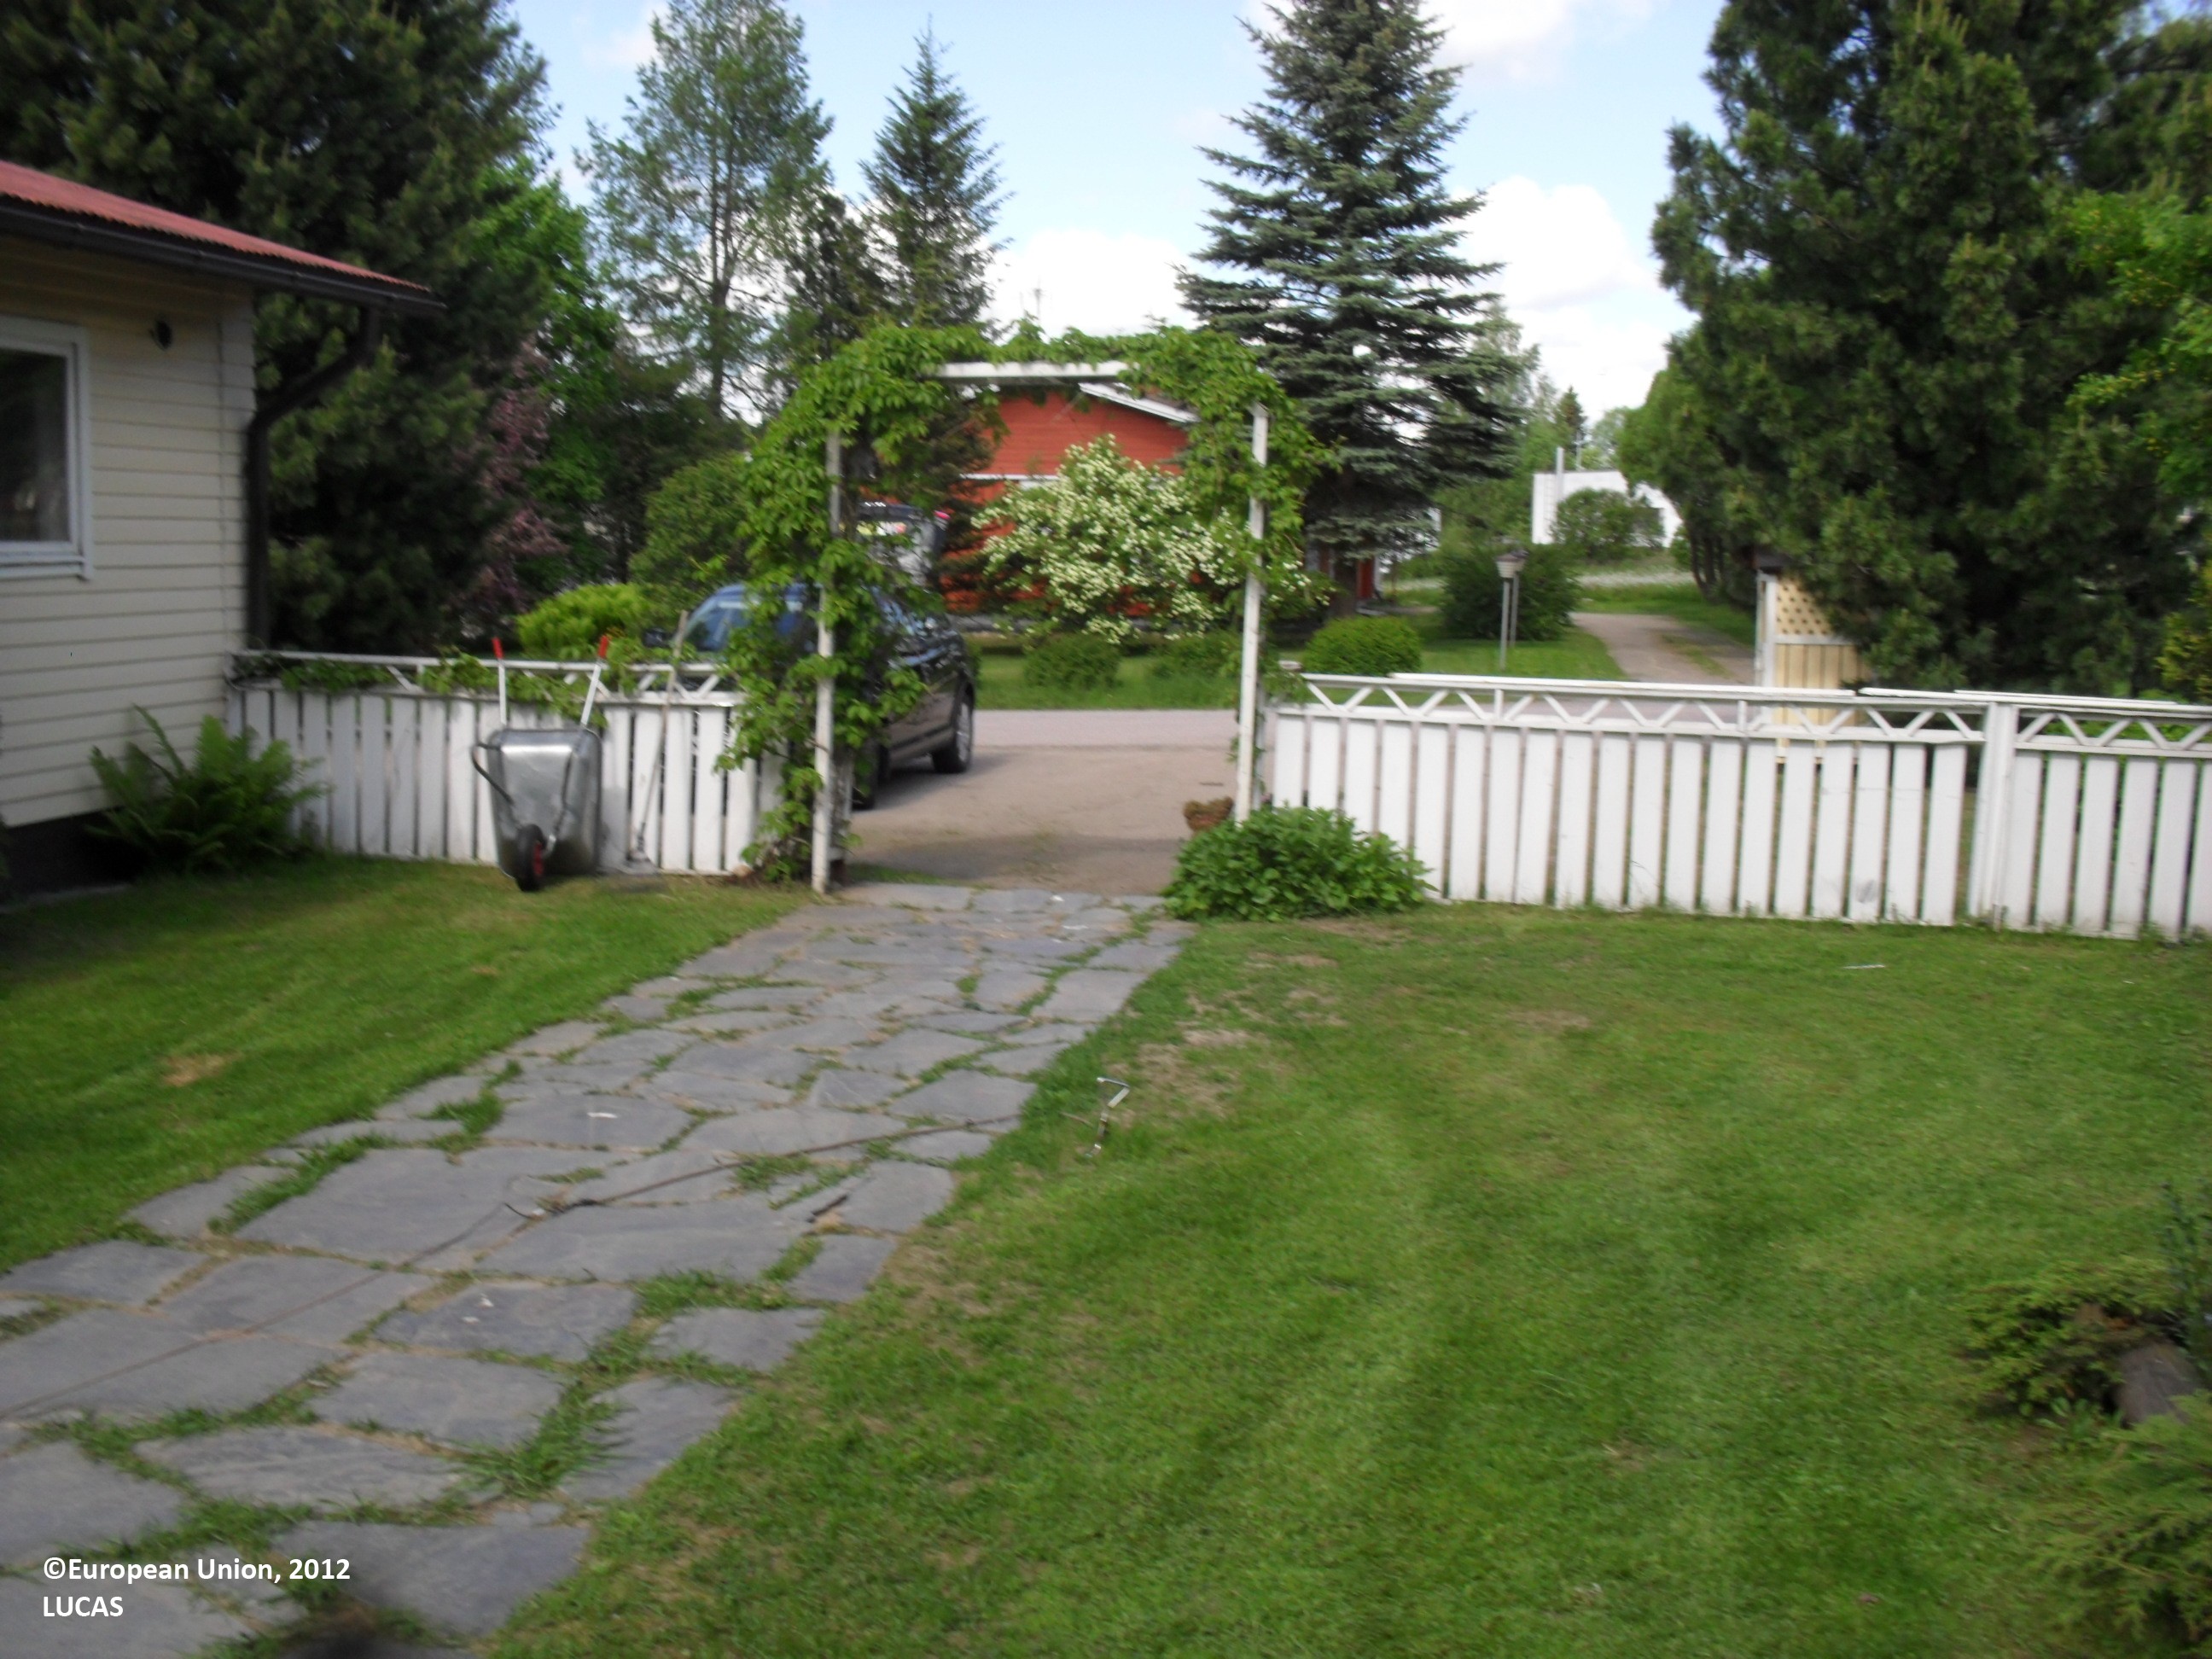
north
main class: Grassland
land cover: Grassland without tree/shrub cover
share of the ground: > 75 %
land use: Residential
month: June
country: FI
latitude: 62.8076
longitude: 23.5045
